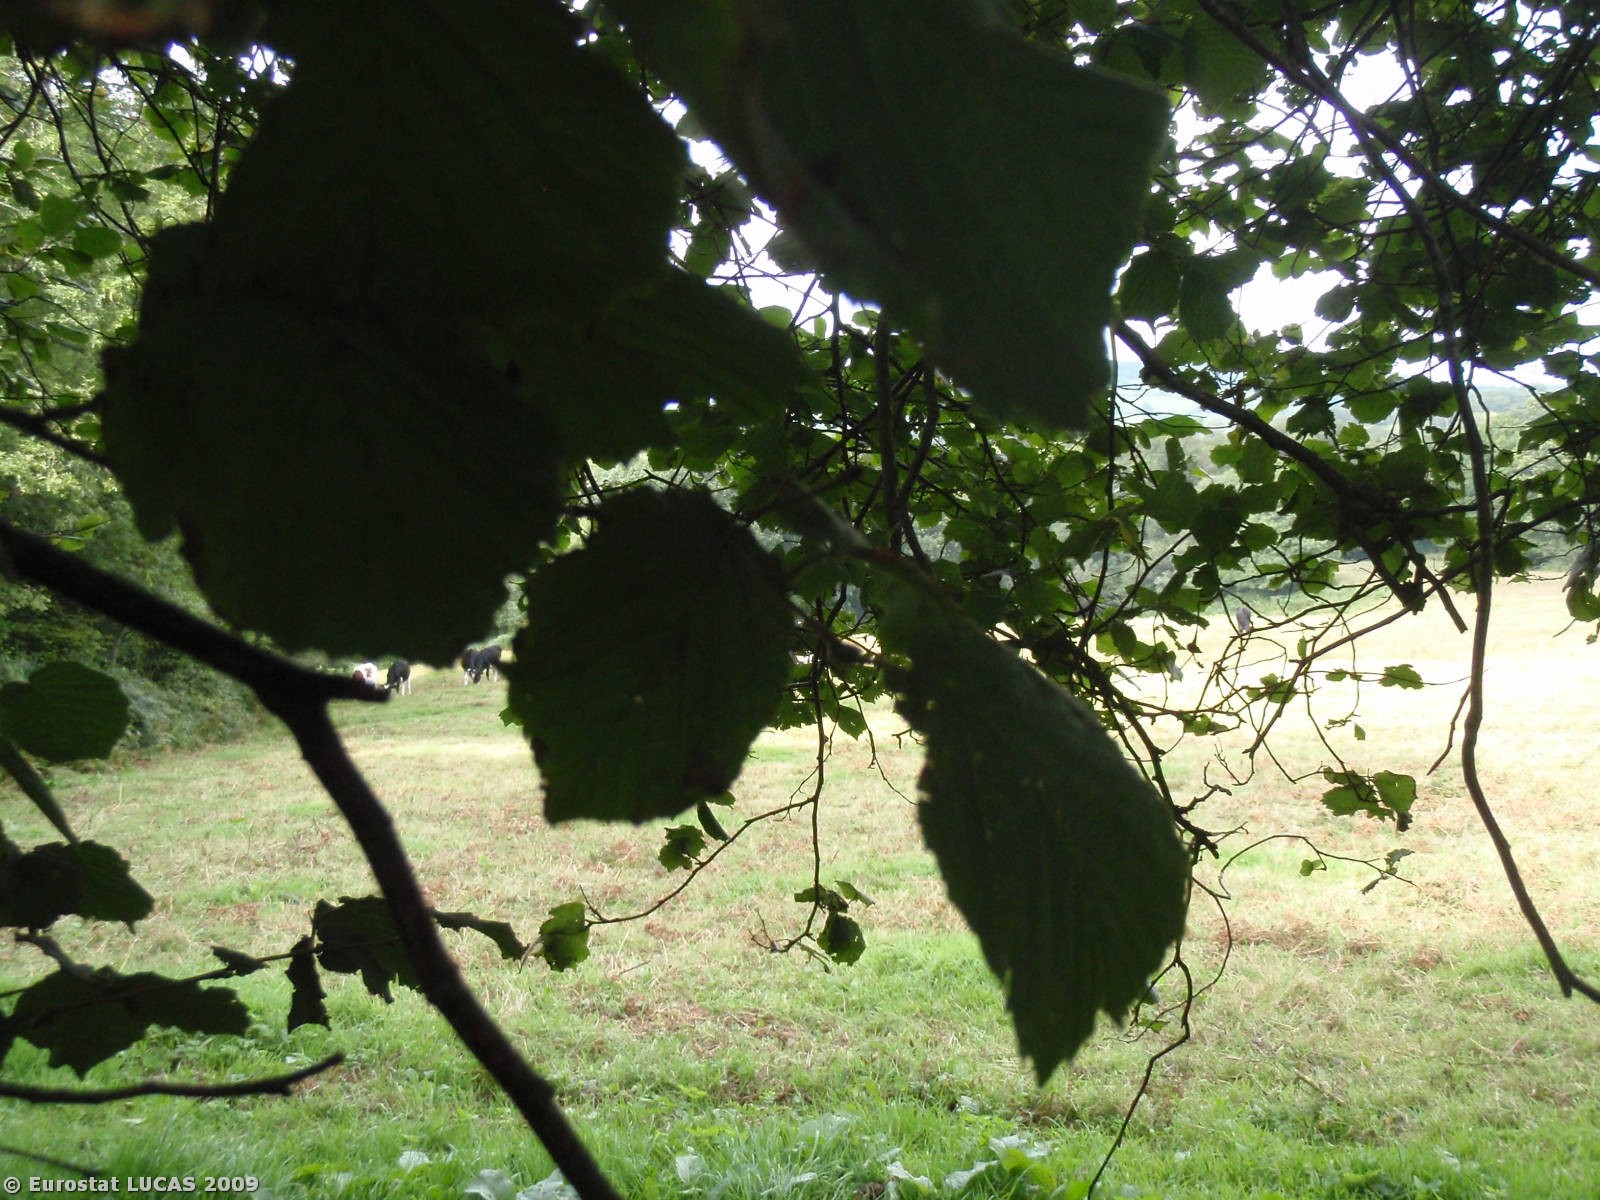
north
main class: Woodland
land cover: Broadleaved woodland
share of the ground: > 75 %
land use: Agriculture (excluding fallow land and kitchen gardens)
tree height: > 5 m
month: August
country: GB
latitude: 50.8545
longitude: -2.6979
